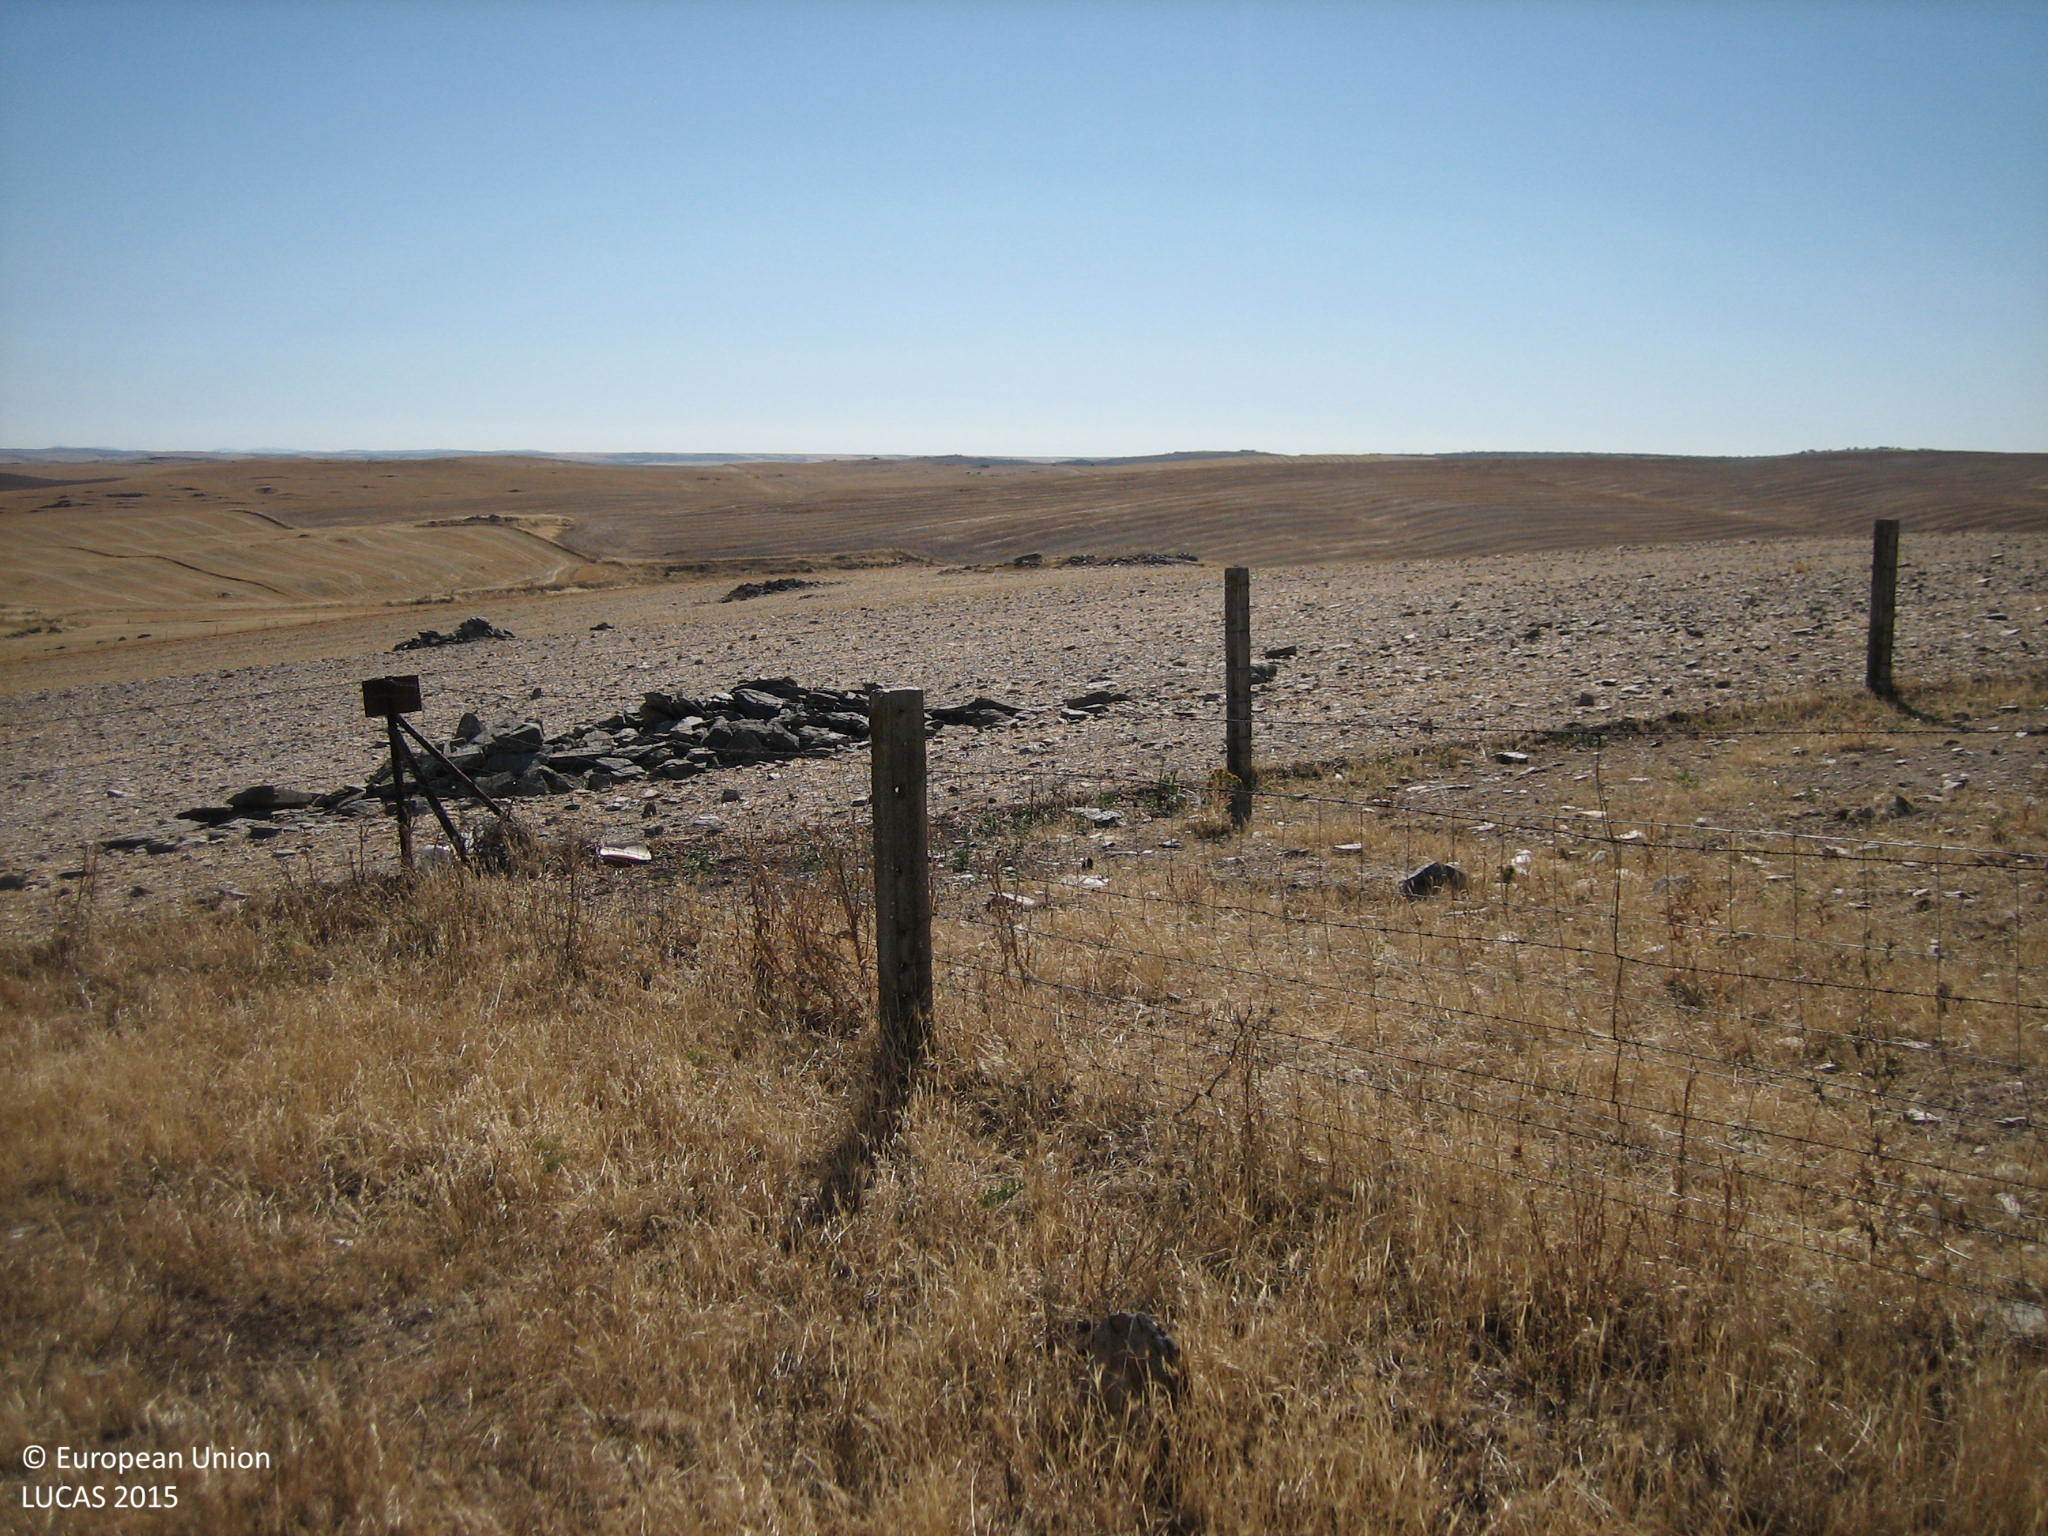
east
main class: Grassland
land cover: Spontaneously vegetated surfaces
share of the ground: > 75 %
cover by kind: herbaceous plants 100 %
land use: Fallow land
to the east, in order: Spontaneously vegetated surfaces; Fences; Spontaneously vegetated surfaces; Fences; Other bare soil; Rock outcrops; Other bare soil
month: July
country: ES
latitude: 38.3710
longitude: -6.1256
